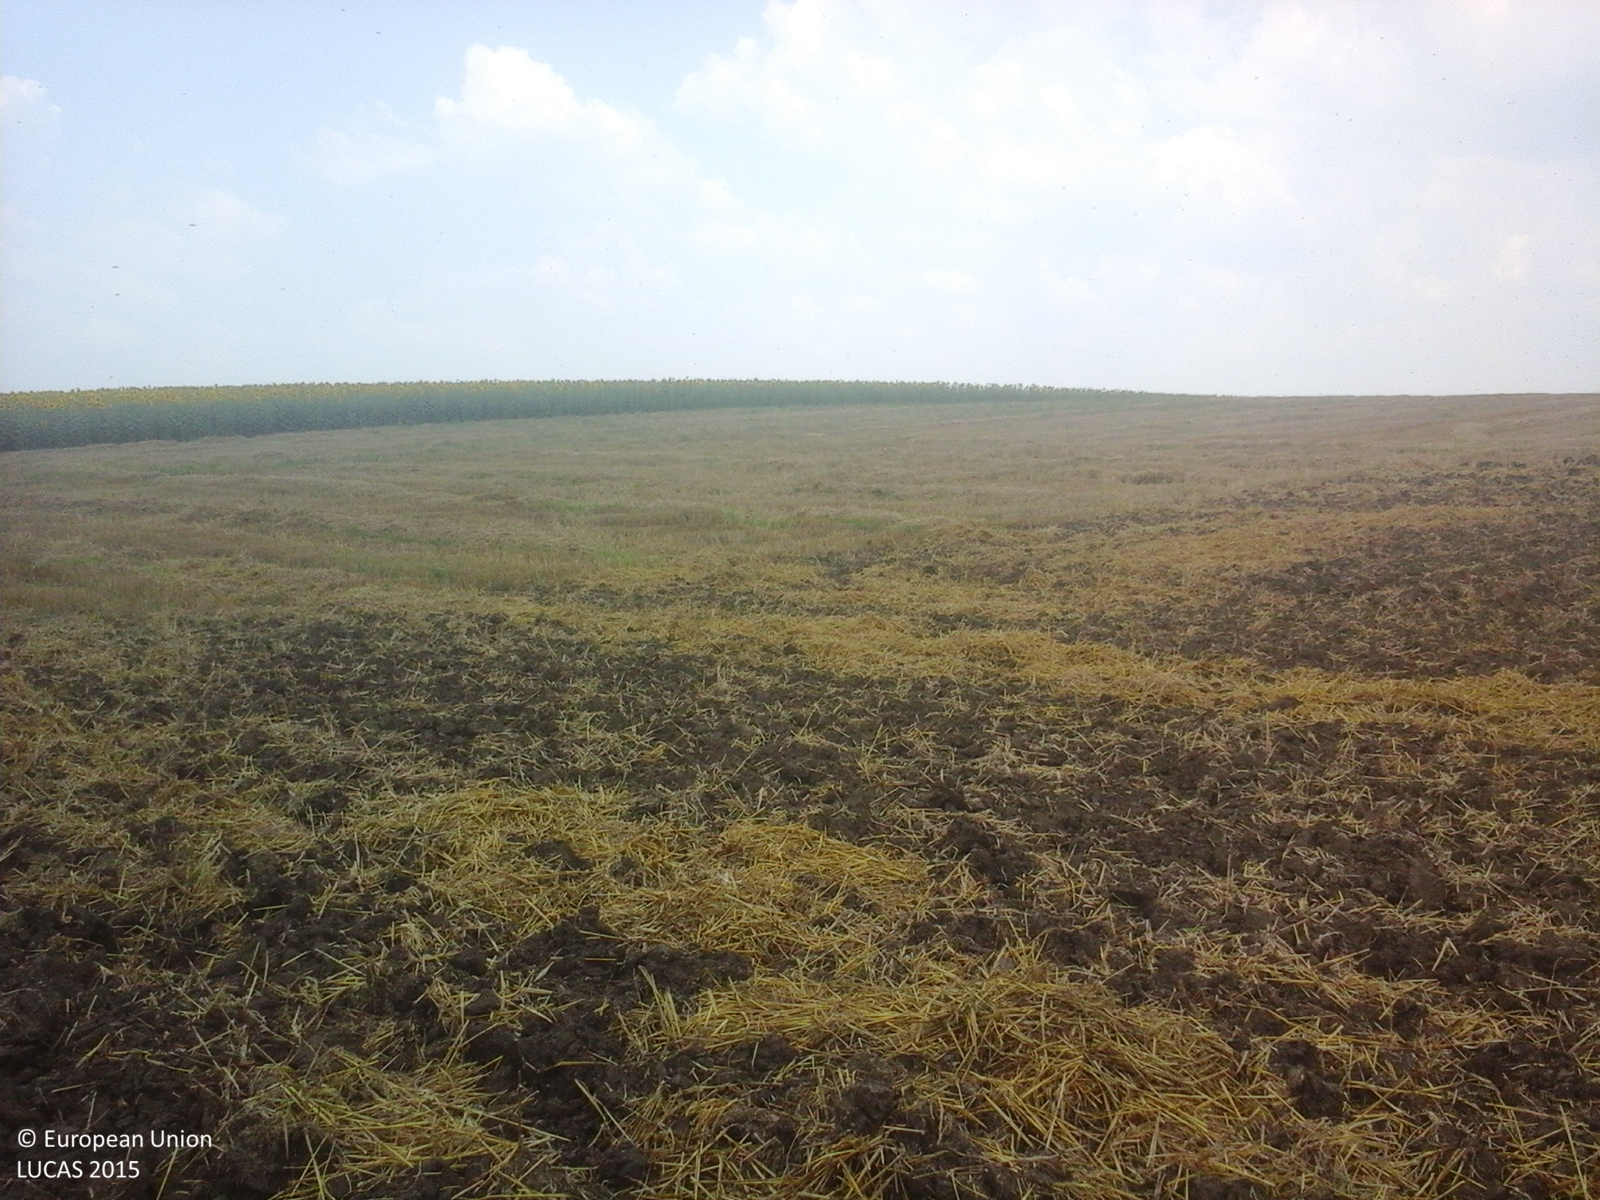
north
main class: Cropland
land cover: Barley
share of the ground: < 10 %
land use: Agriculture (excluding fallow land and kitchen gardens)
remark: Harvested field
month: July
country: RO
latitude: 43.7841
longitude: 25.1244
